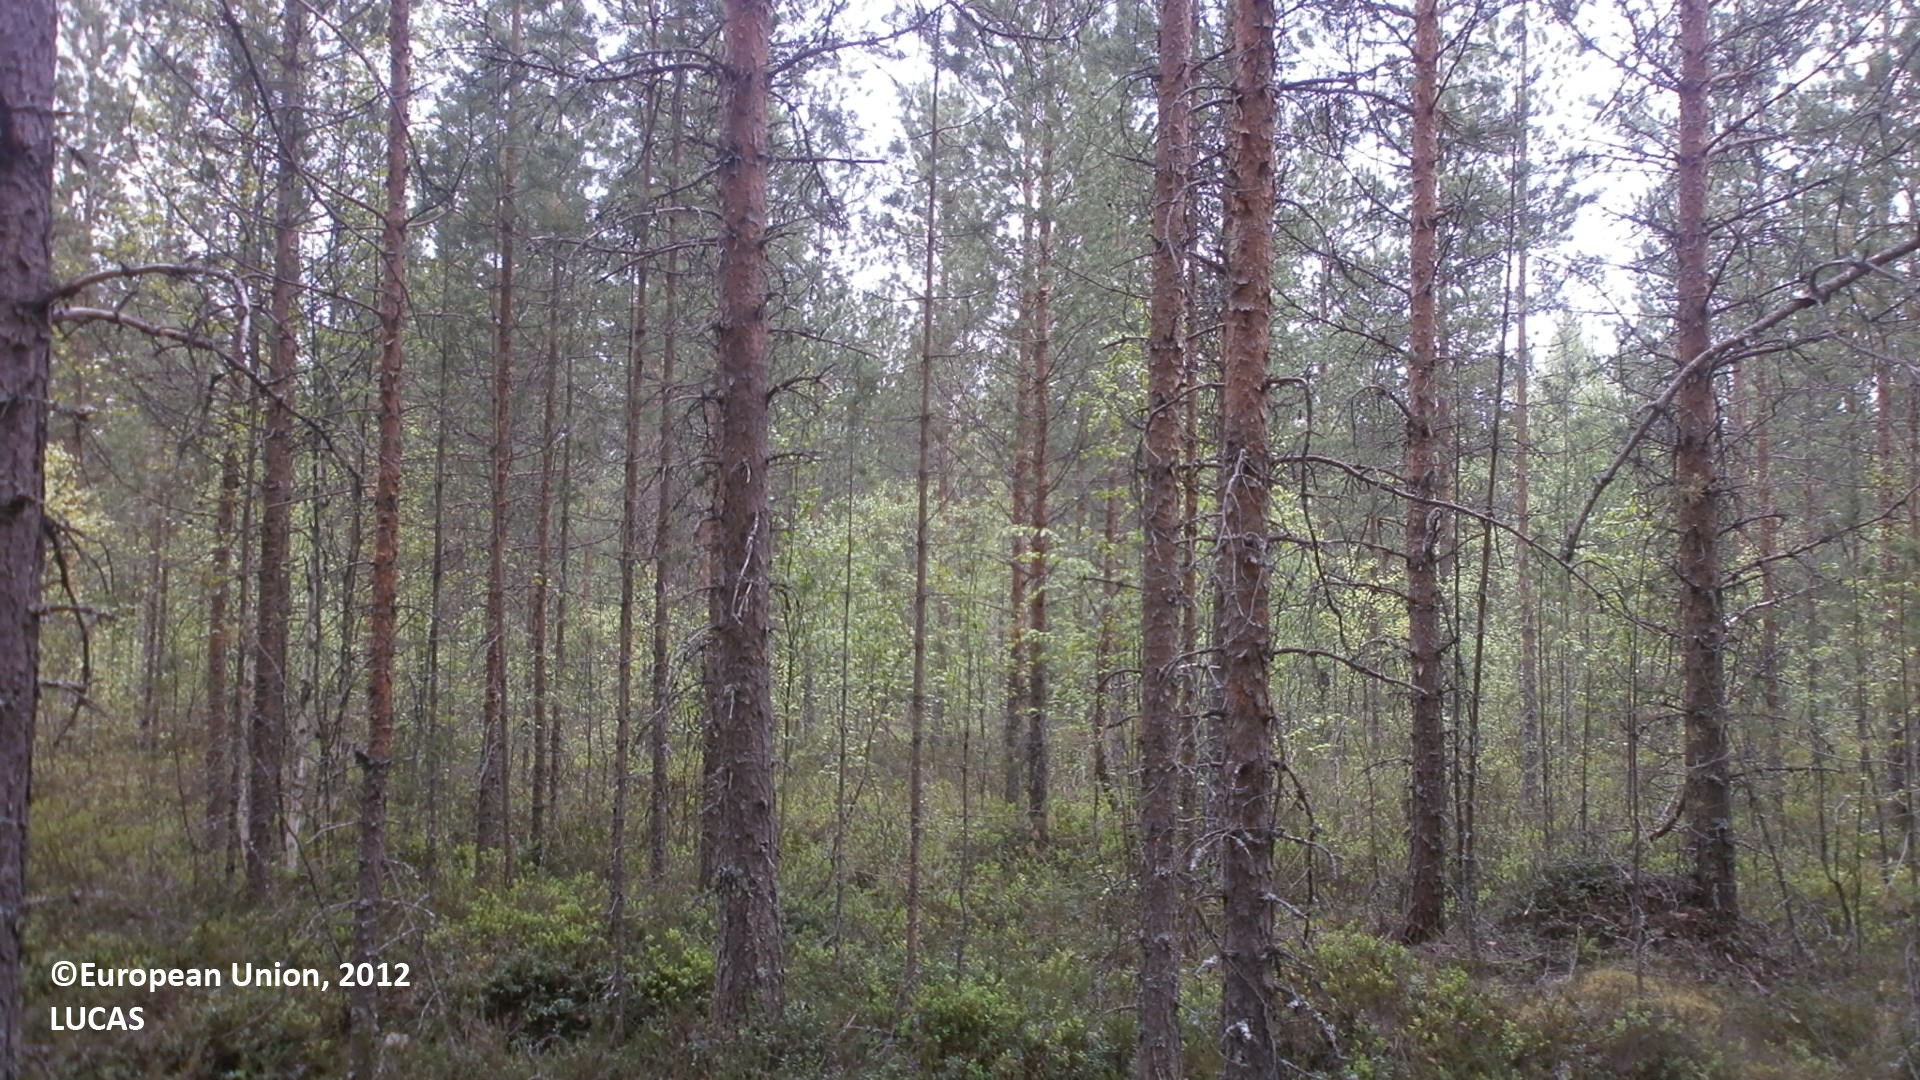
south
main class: Woodland
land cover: Pine dominated coniferous woodland
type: mire and swamp forests
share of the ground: 50 - 75 %
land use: Forestry
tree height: > 5 m
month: June
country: FI
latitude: 64.3883
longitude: 25.1149
